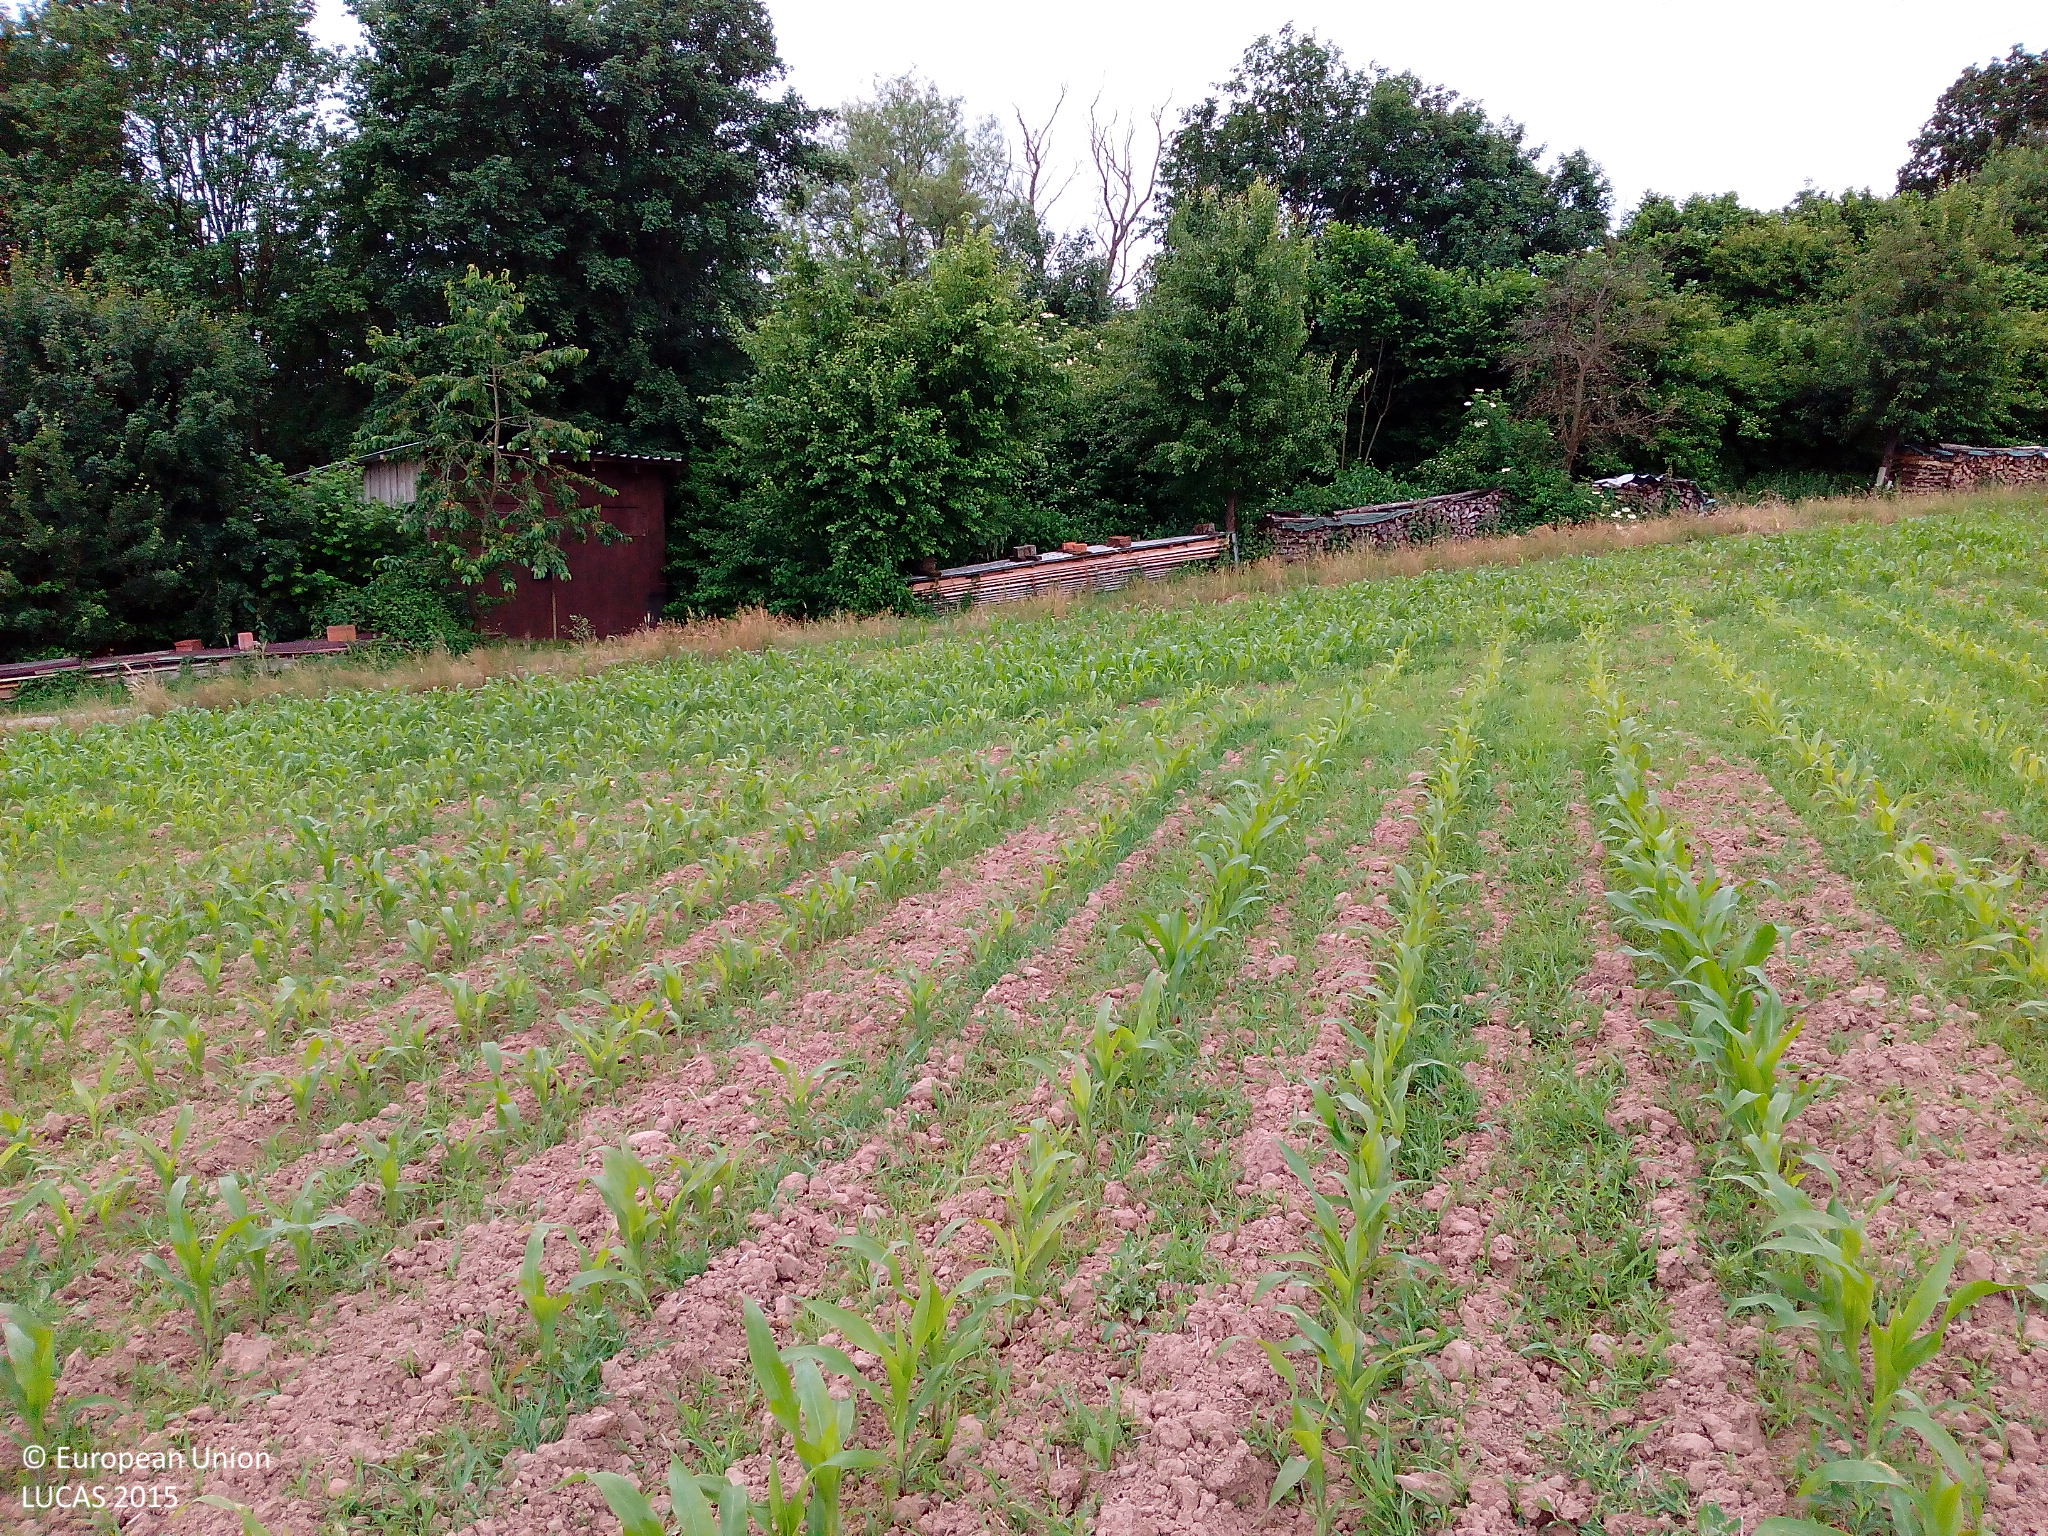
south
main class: Cropland
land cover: Maize
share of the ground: 25 - 50 %
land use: Agriculture (excluding fallow land and kitchen gardens)
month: June
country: DE
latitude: 50.9027
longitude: 9.5877
